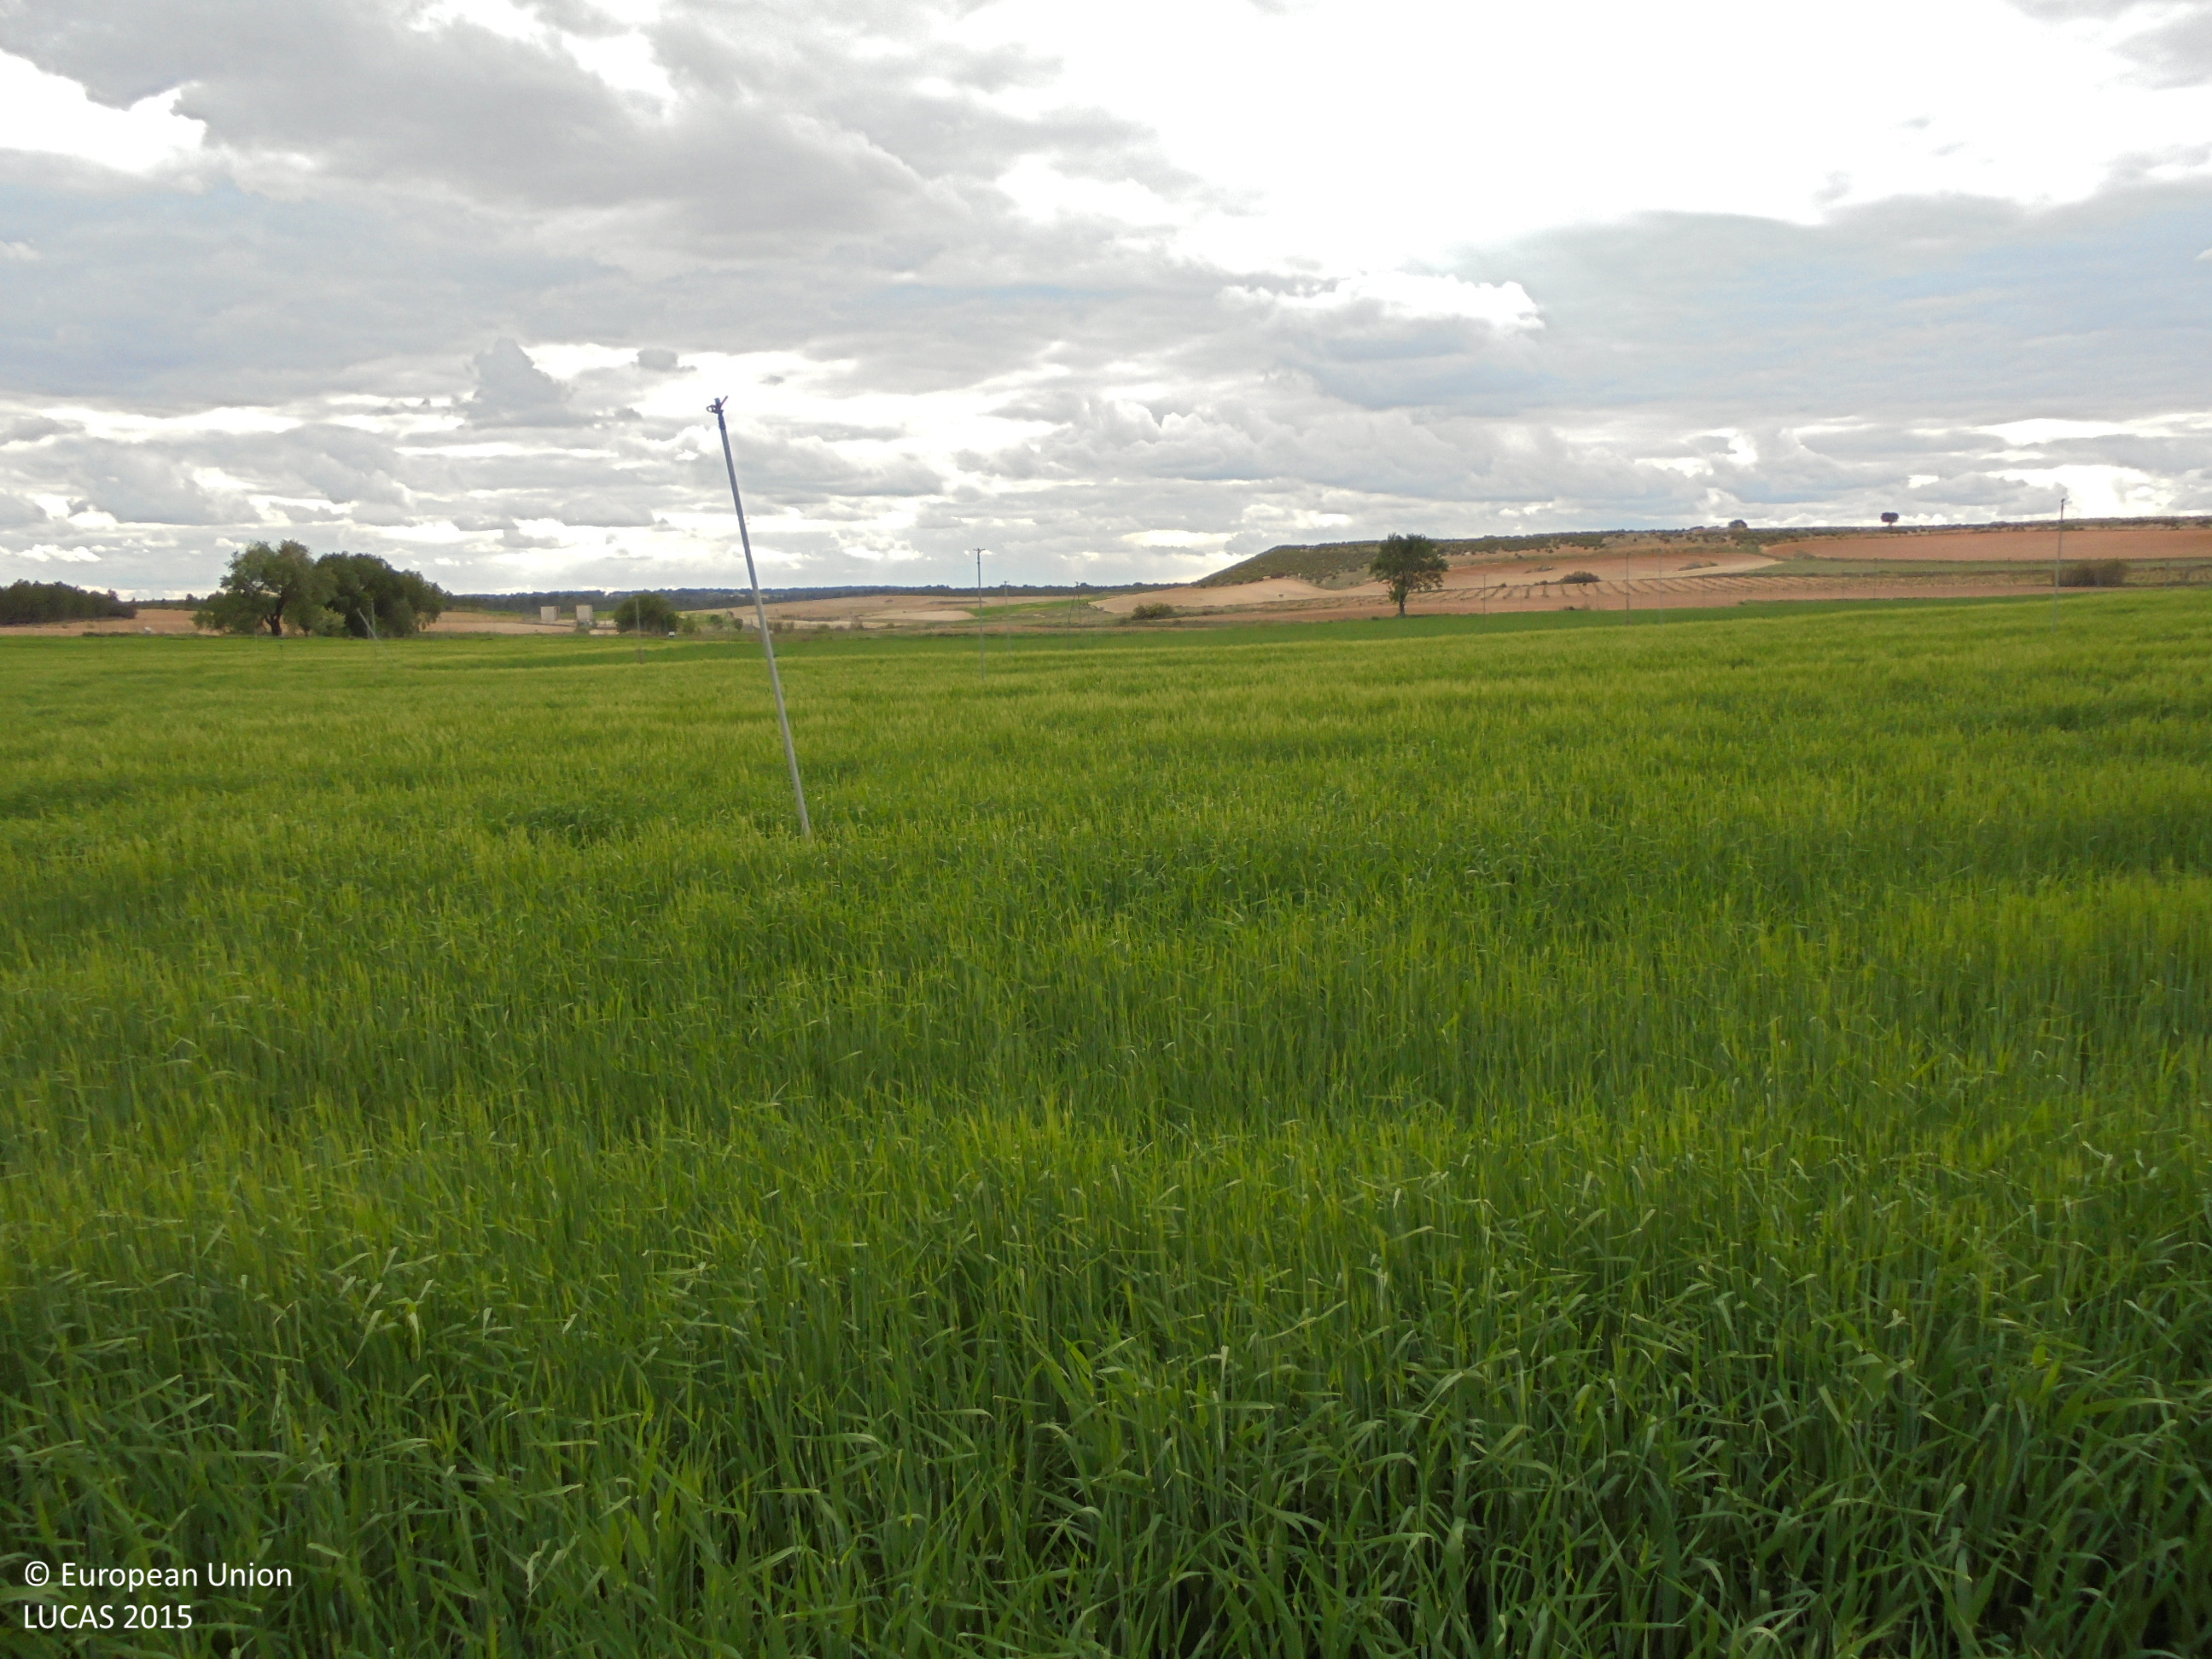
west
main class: Cropland
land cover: Barley
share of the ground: > 75 %
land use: Agriculture (excluding fallow land and kitchen gardens)
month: April
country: ES
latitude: 39.1693
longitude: -1.7964
